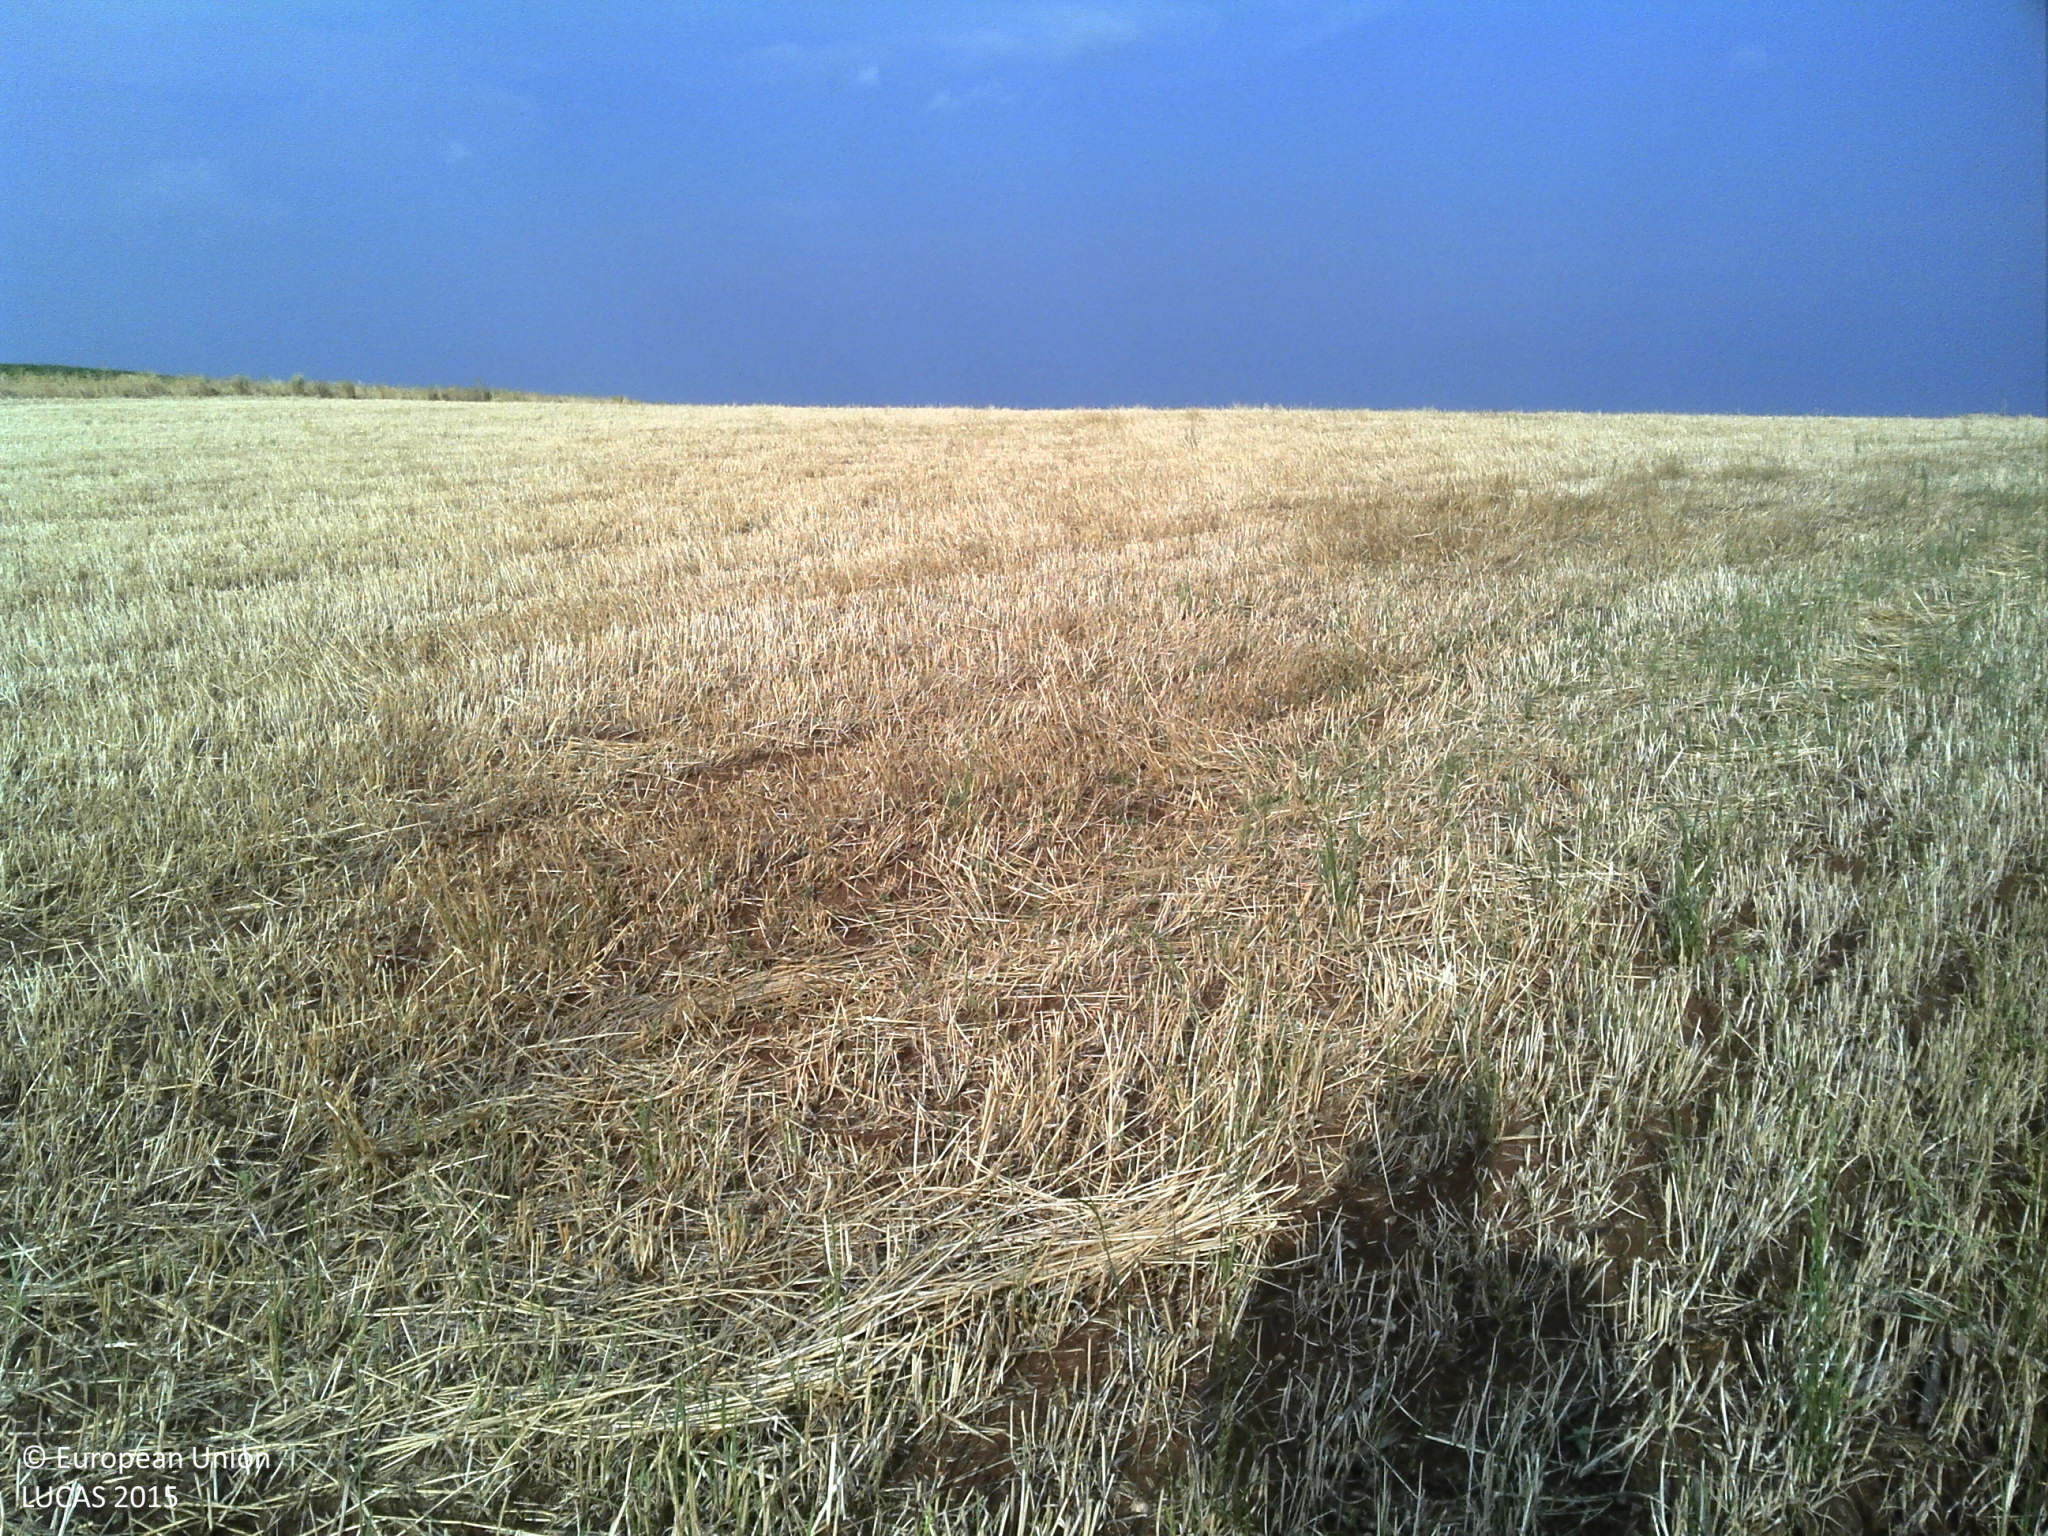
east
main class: Cropland
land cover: Maize
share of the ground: > 75 %
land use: Agriculture (excluding fallow land and kitchen gardens)
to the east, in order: Maize; Oats; Grass margins; Tracks; Grass margins; Oats
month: June
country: PT
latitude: 37.9062
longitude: -7.5913
